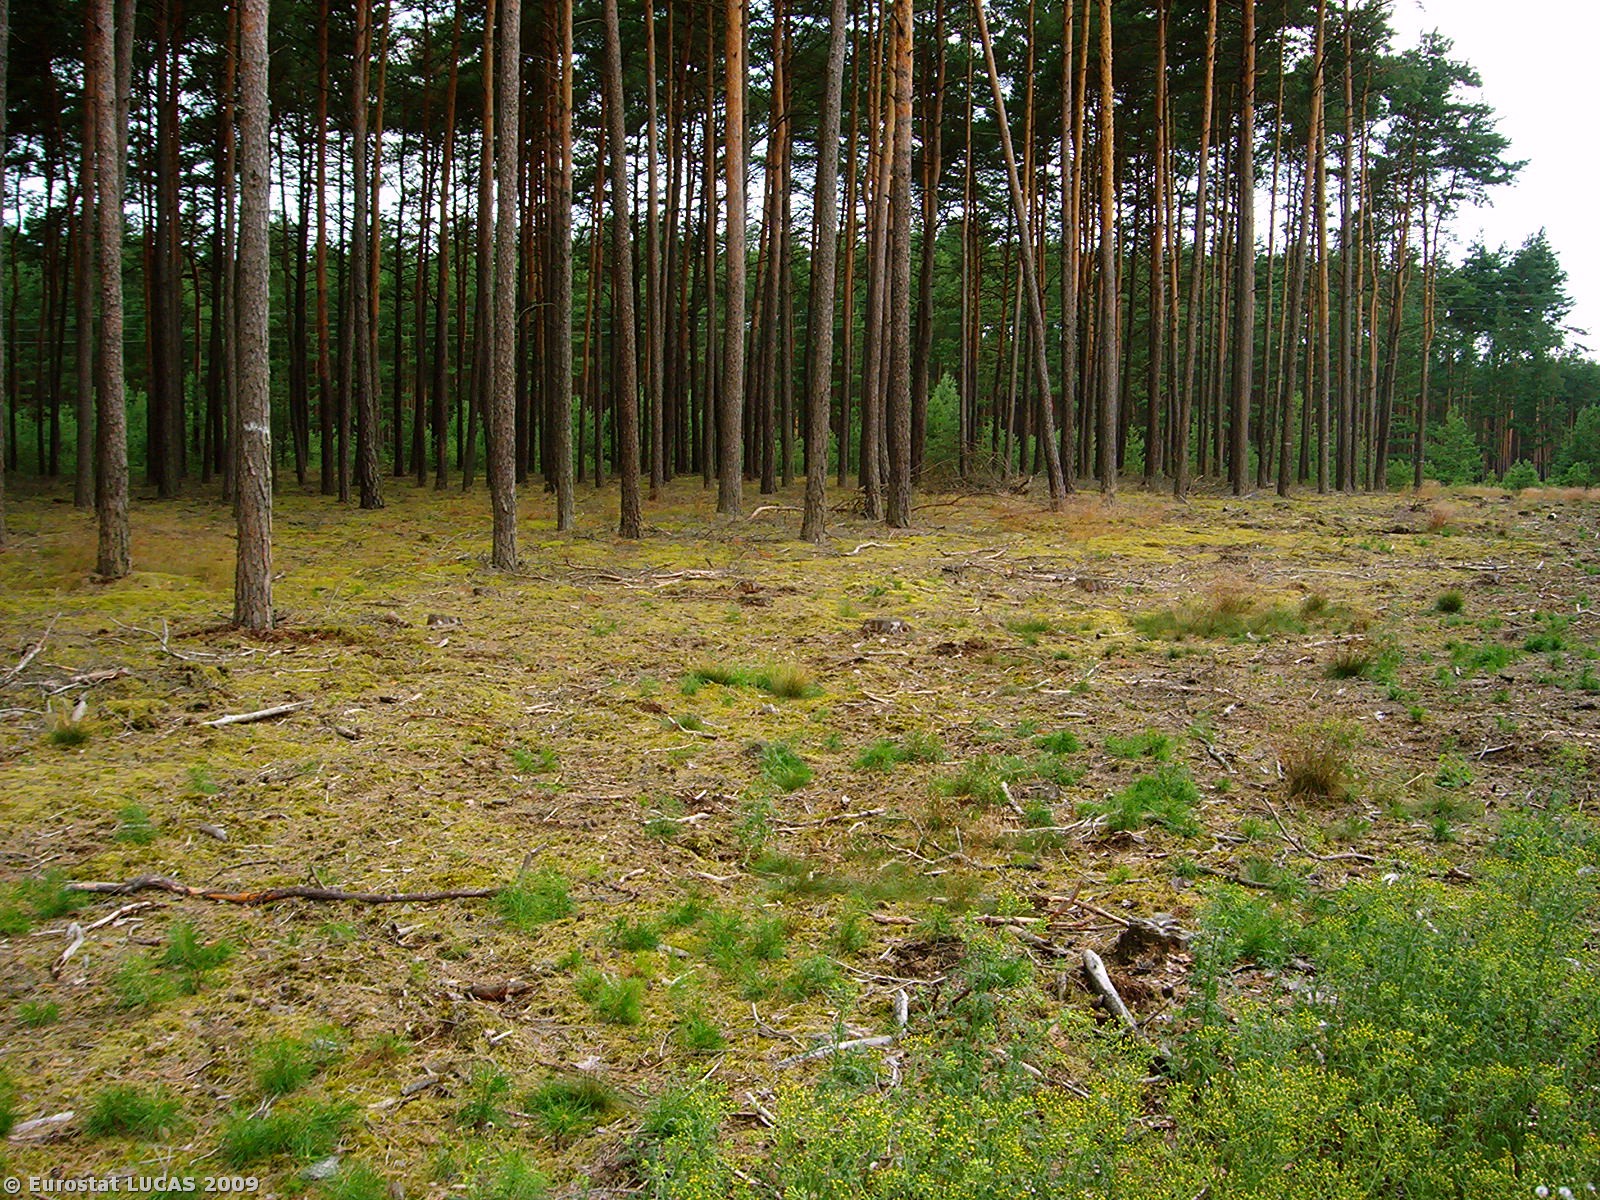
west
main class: Grassland
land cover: Spontaneously vegetated surfaces
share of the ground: 25 - 50 %
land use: Forestry
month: July
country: PL
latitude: 52.6152
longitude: 15.3944
